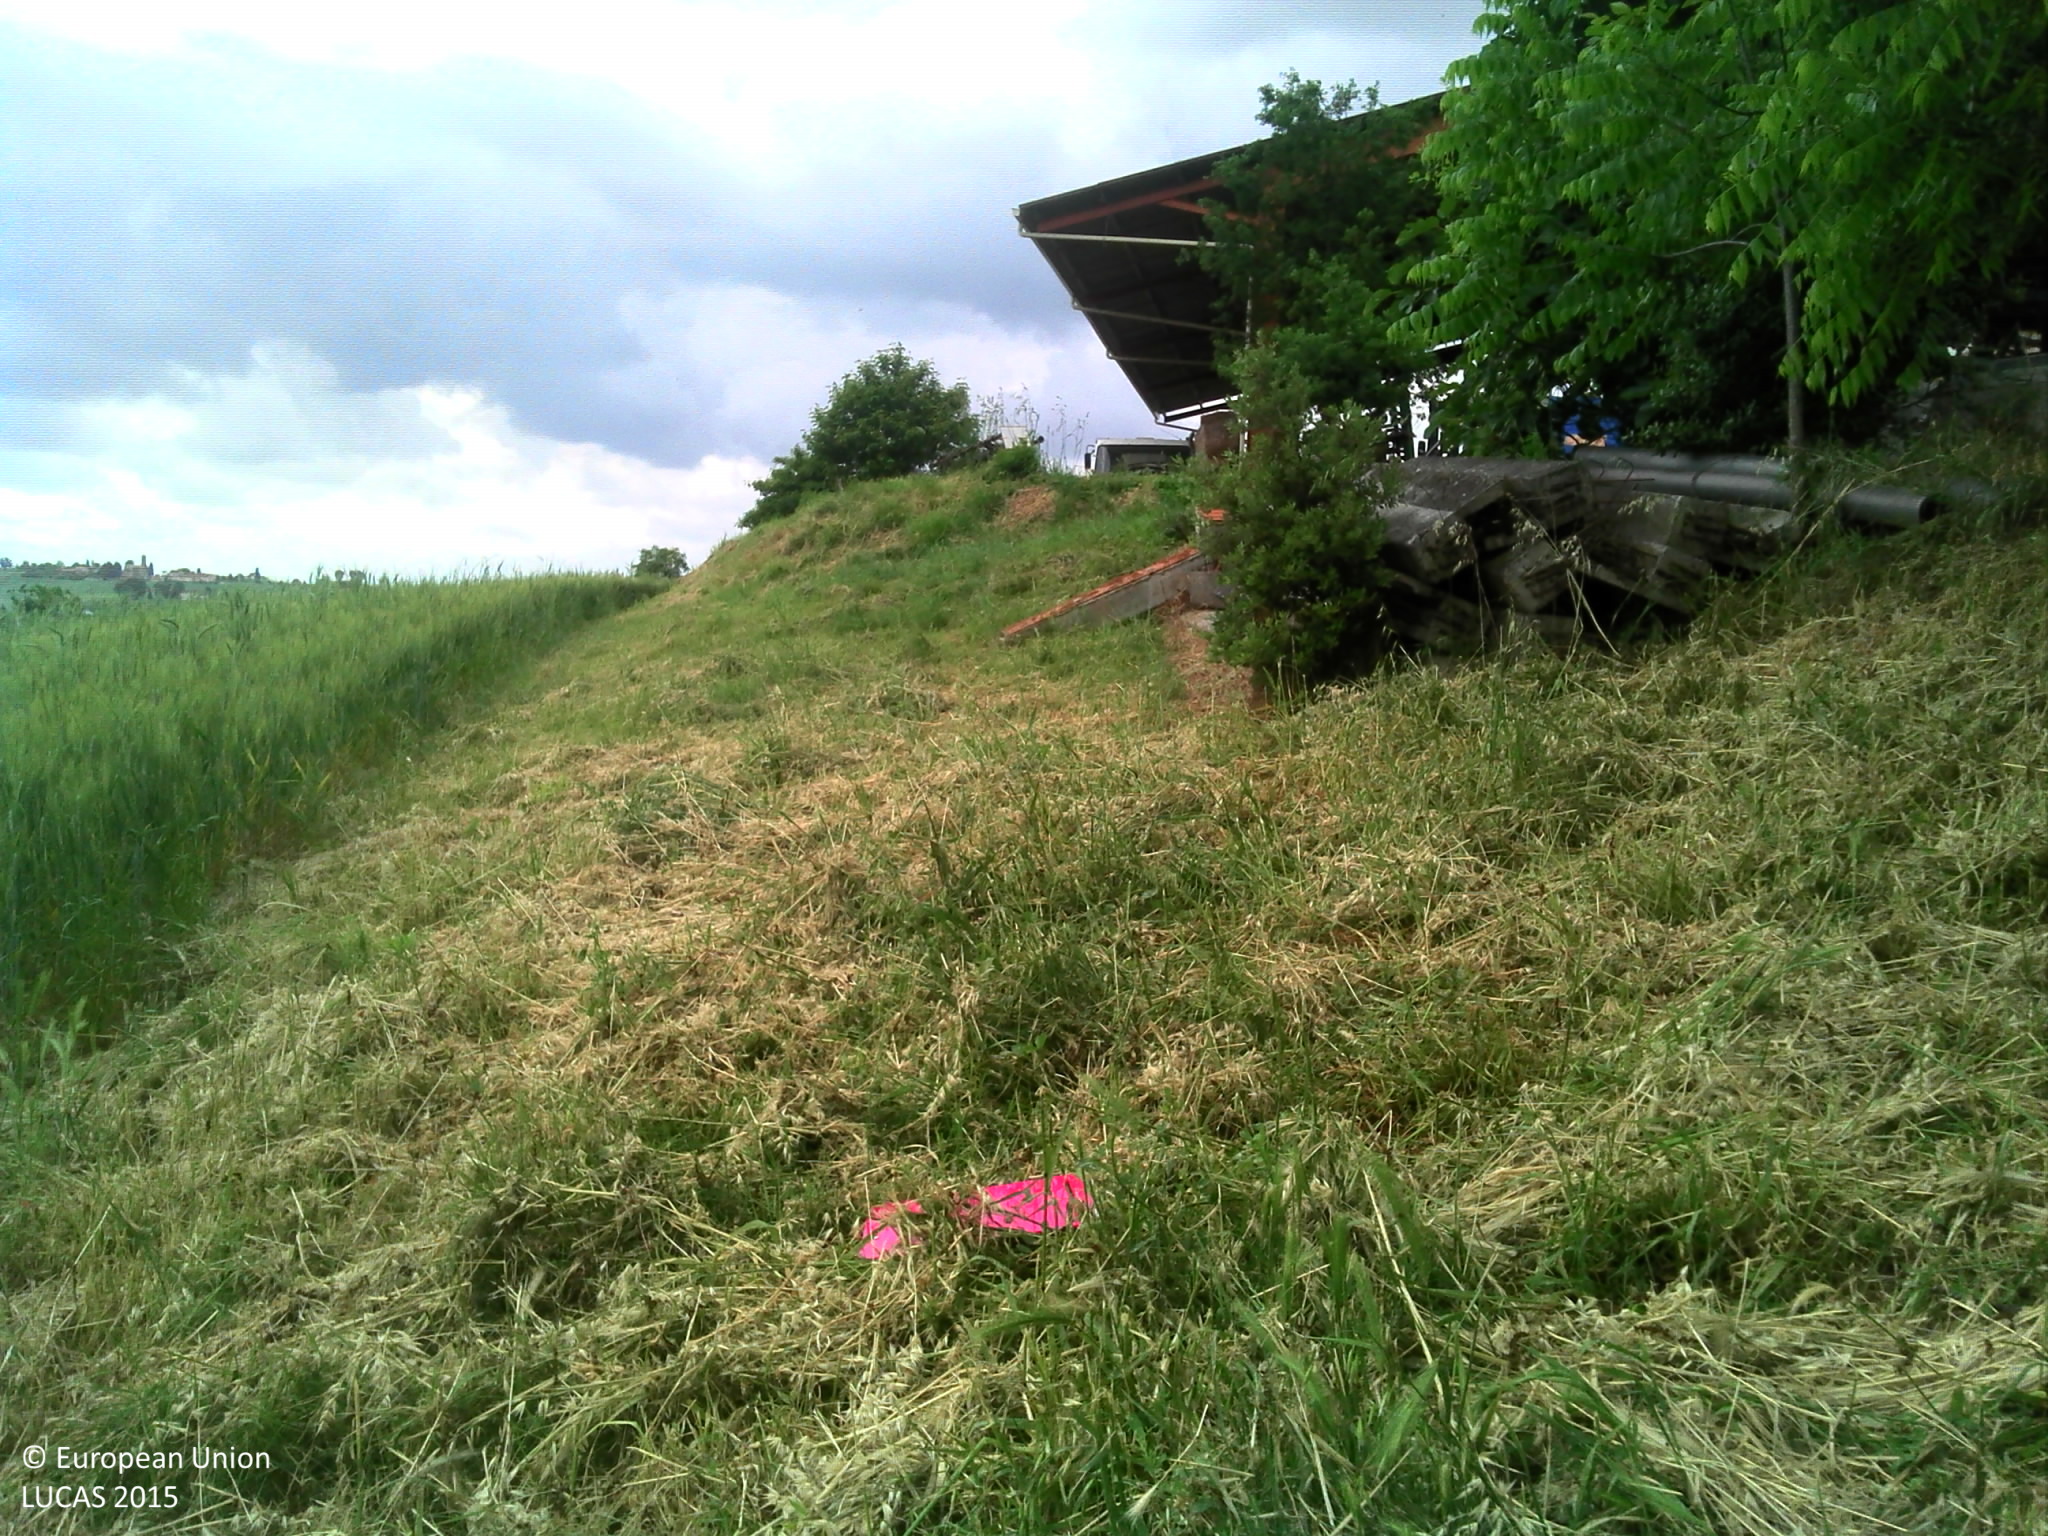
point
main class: Grassland
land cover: Grassland with sparse tree/shrub cover
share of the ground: > 75 %
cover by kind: herbaceous plants 95 %, broadleaved forest trees 5 %
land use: Agriculture (excluding fallow land and kitchen gardens)
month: May
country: FR
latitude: 43.7115
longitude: 1.7252
